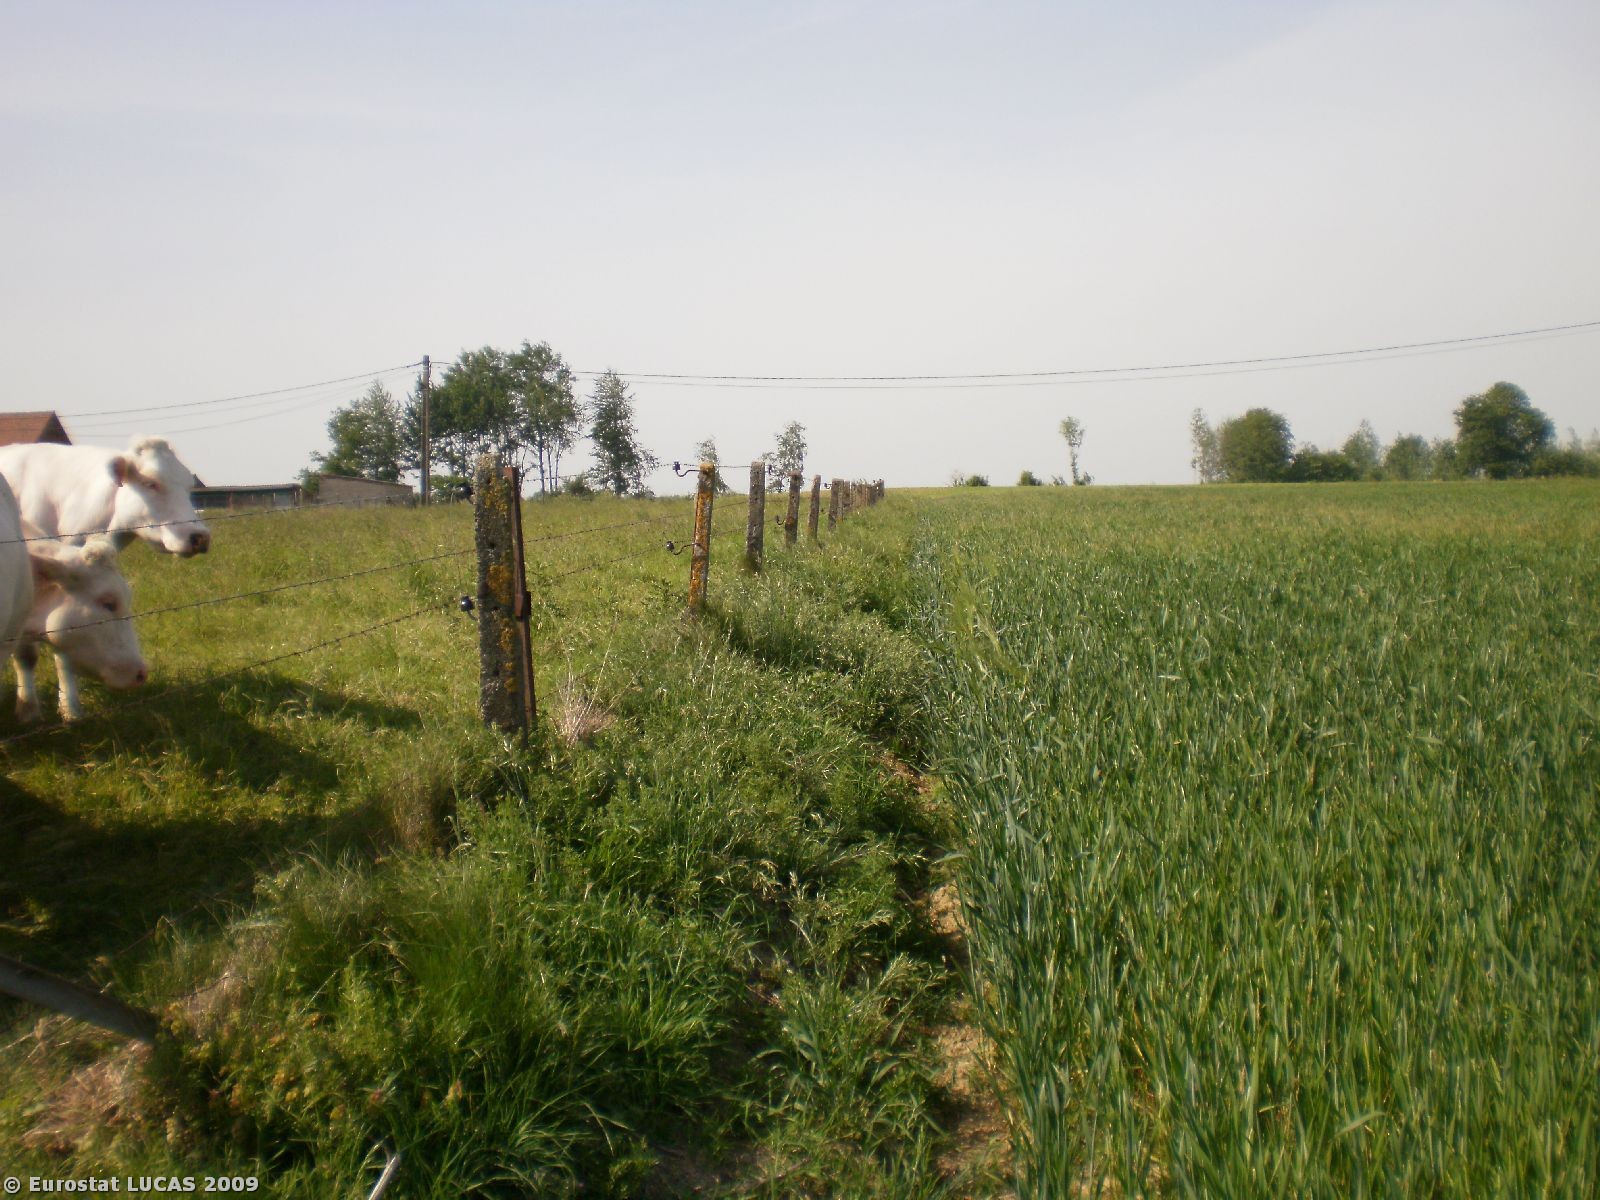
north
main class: Cropland
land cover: Barley
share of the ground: > 75 %
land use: Agriculture (excluding fallow land and kitchen gardens)
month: May
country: BE
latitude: 50.6295
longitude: 3.8156
